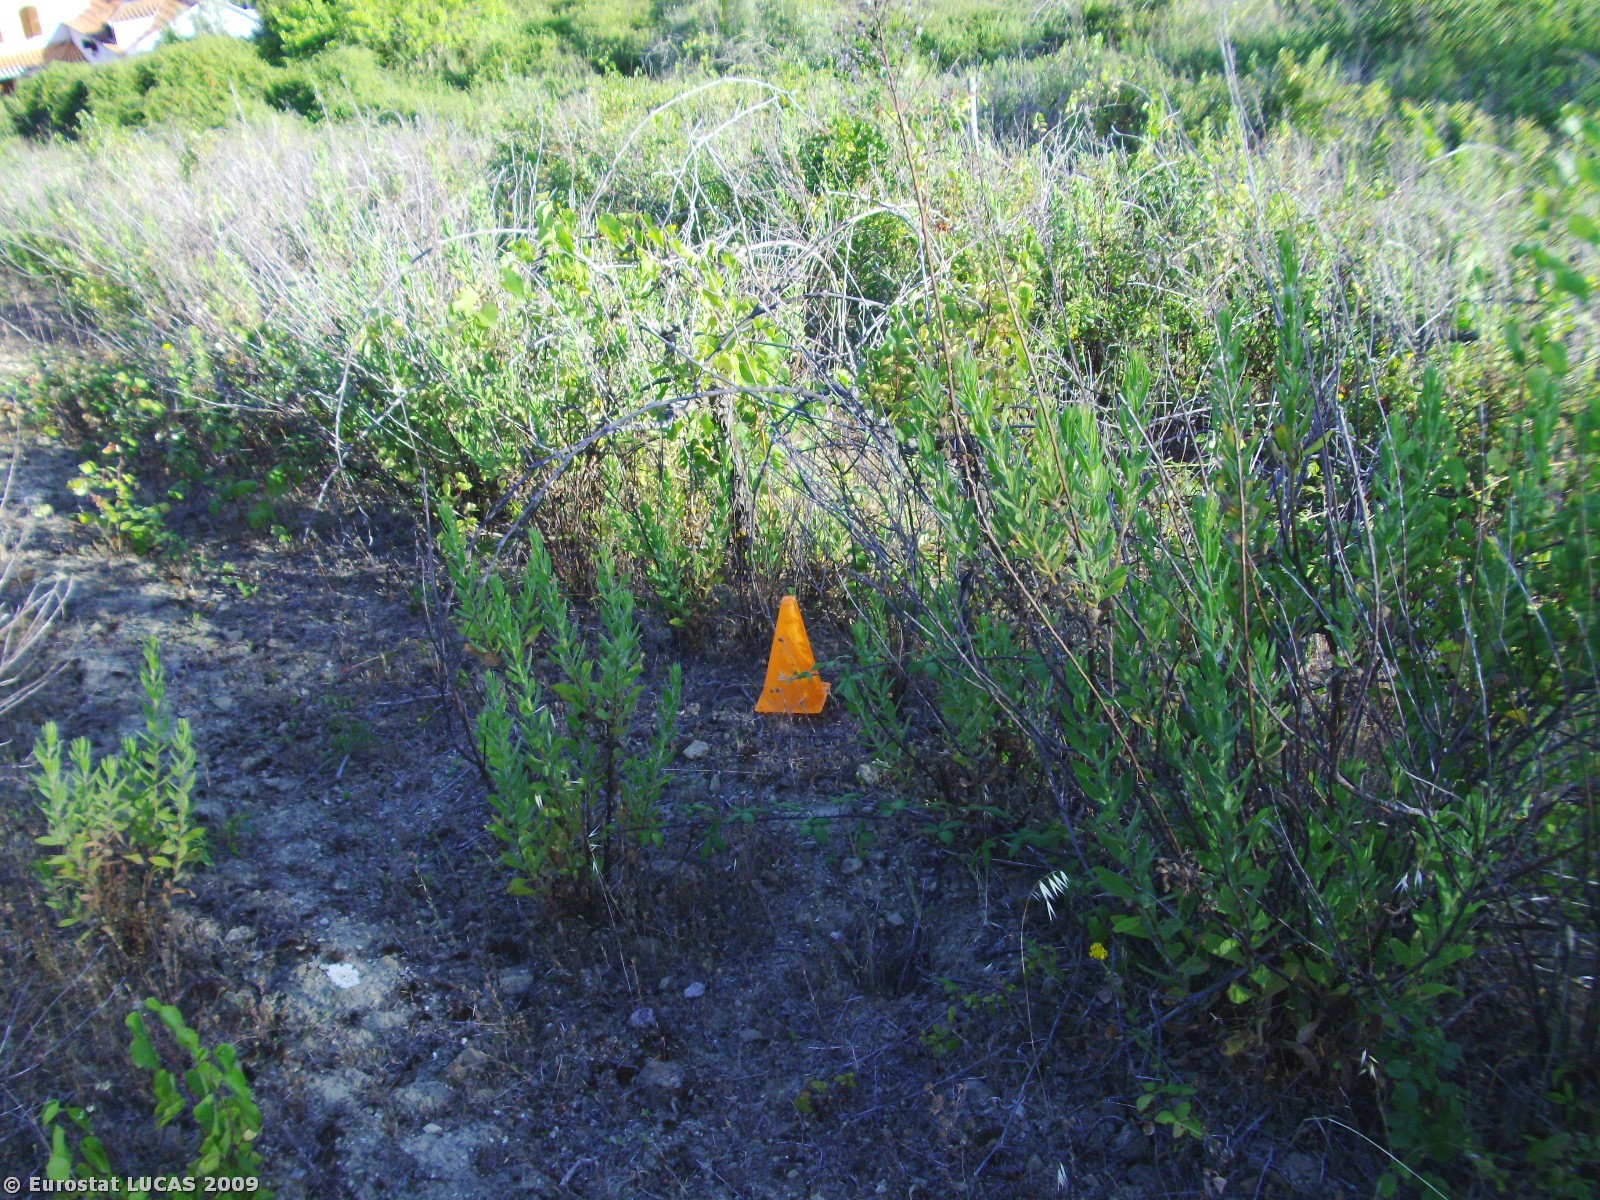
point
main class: Cropland
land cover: Vineyards
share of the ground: 25 - 50 %
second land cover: Shrubland without tree cover
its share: 50 - 75 %
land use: Fallow land
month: July
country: PT
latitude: 38.9802
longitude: -9.0198
